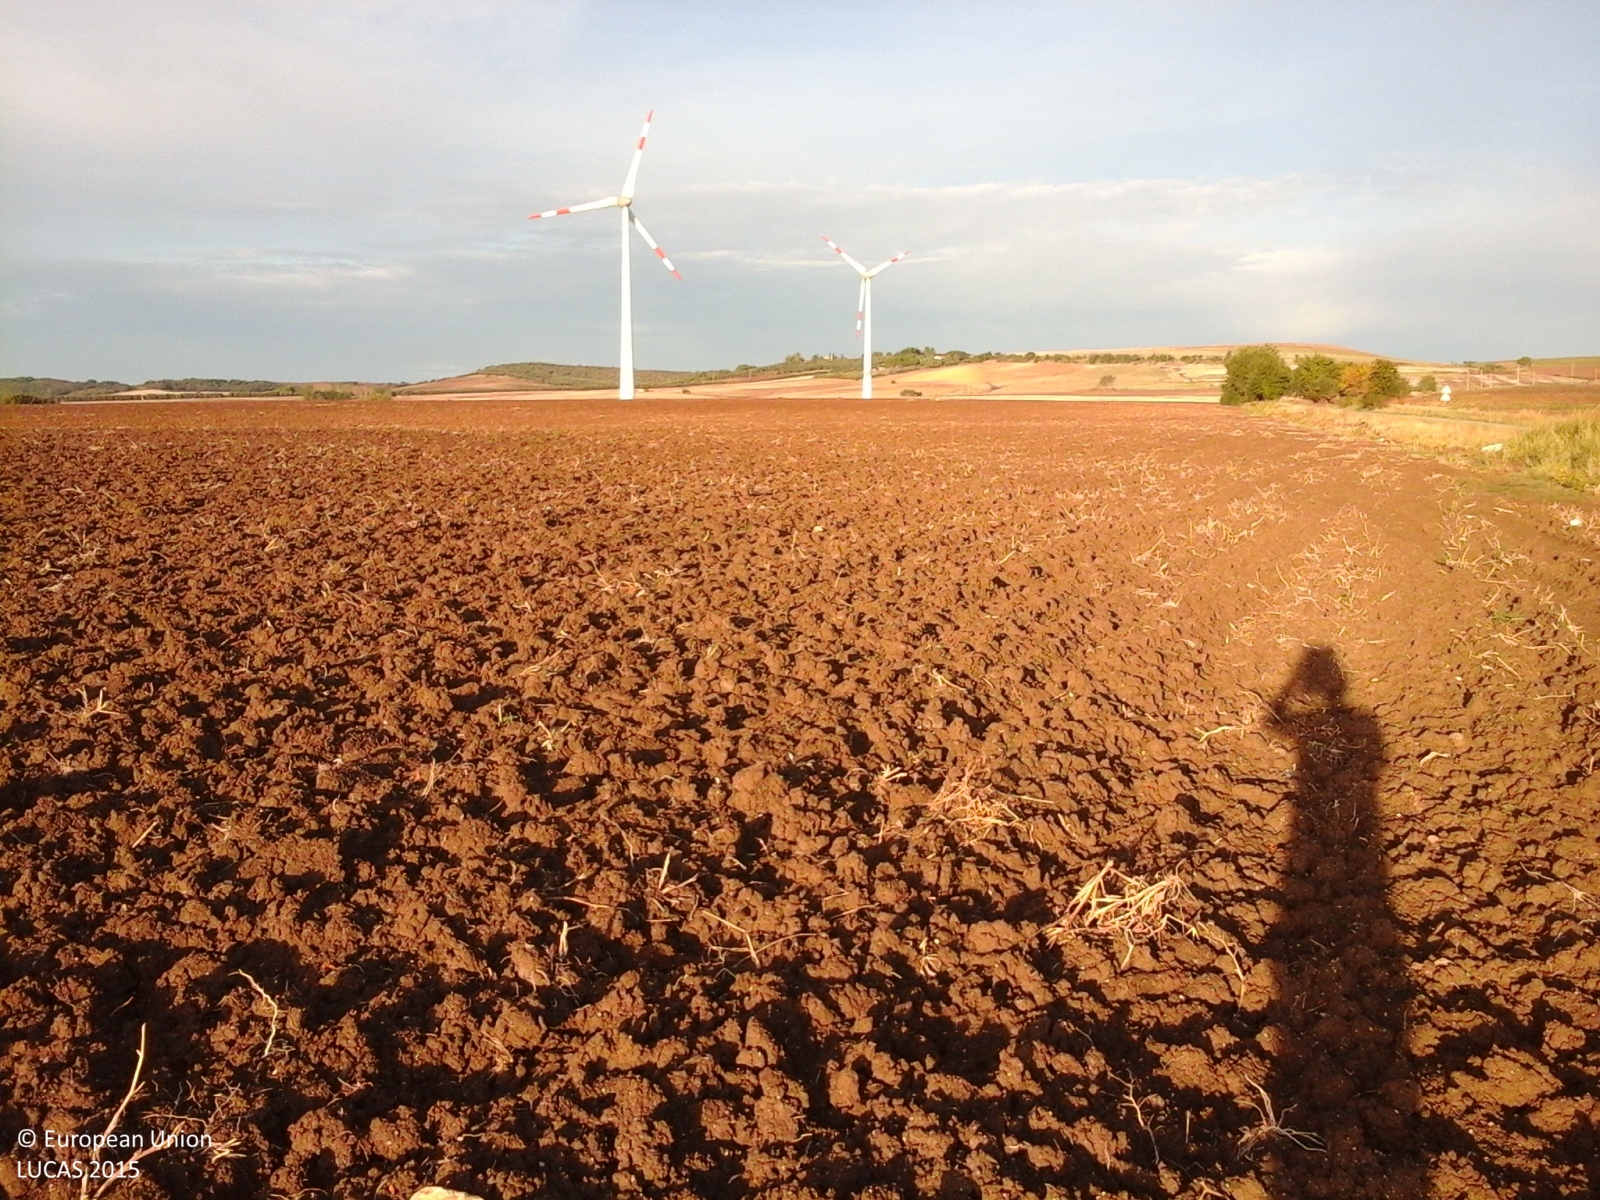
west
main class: Cropland
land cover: Tomatoes
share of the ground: > 75 %
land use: Agriculture (excluding fallow land and kitchen gardens)
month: October
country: IT
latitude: 41.8496
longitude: 15.2233
